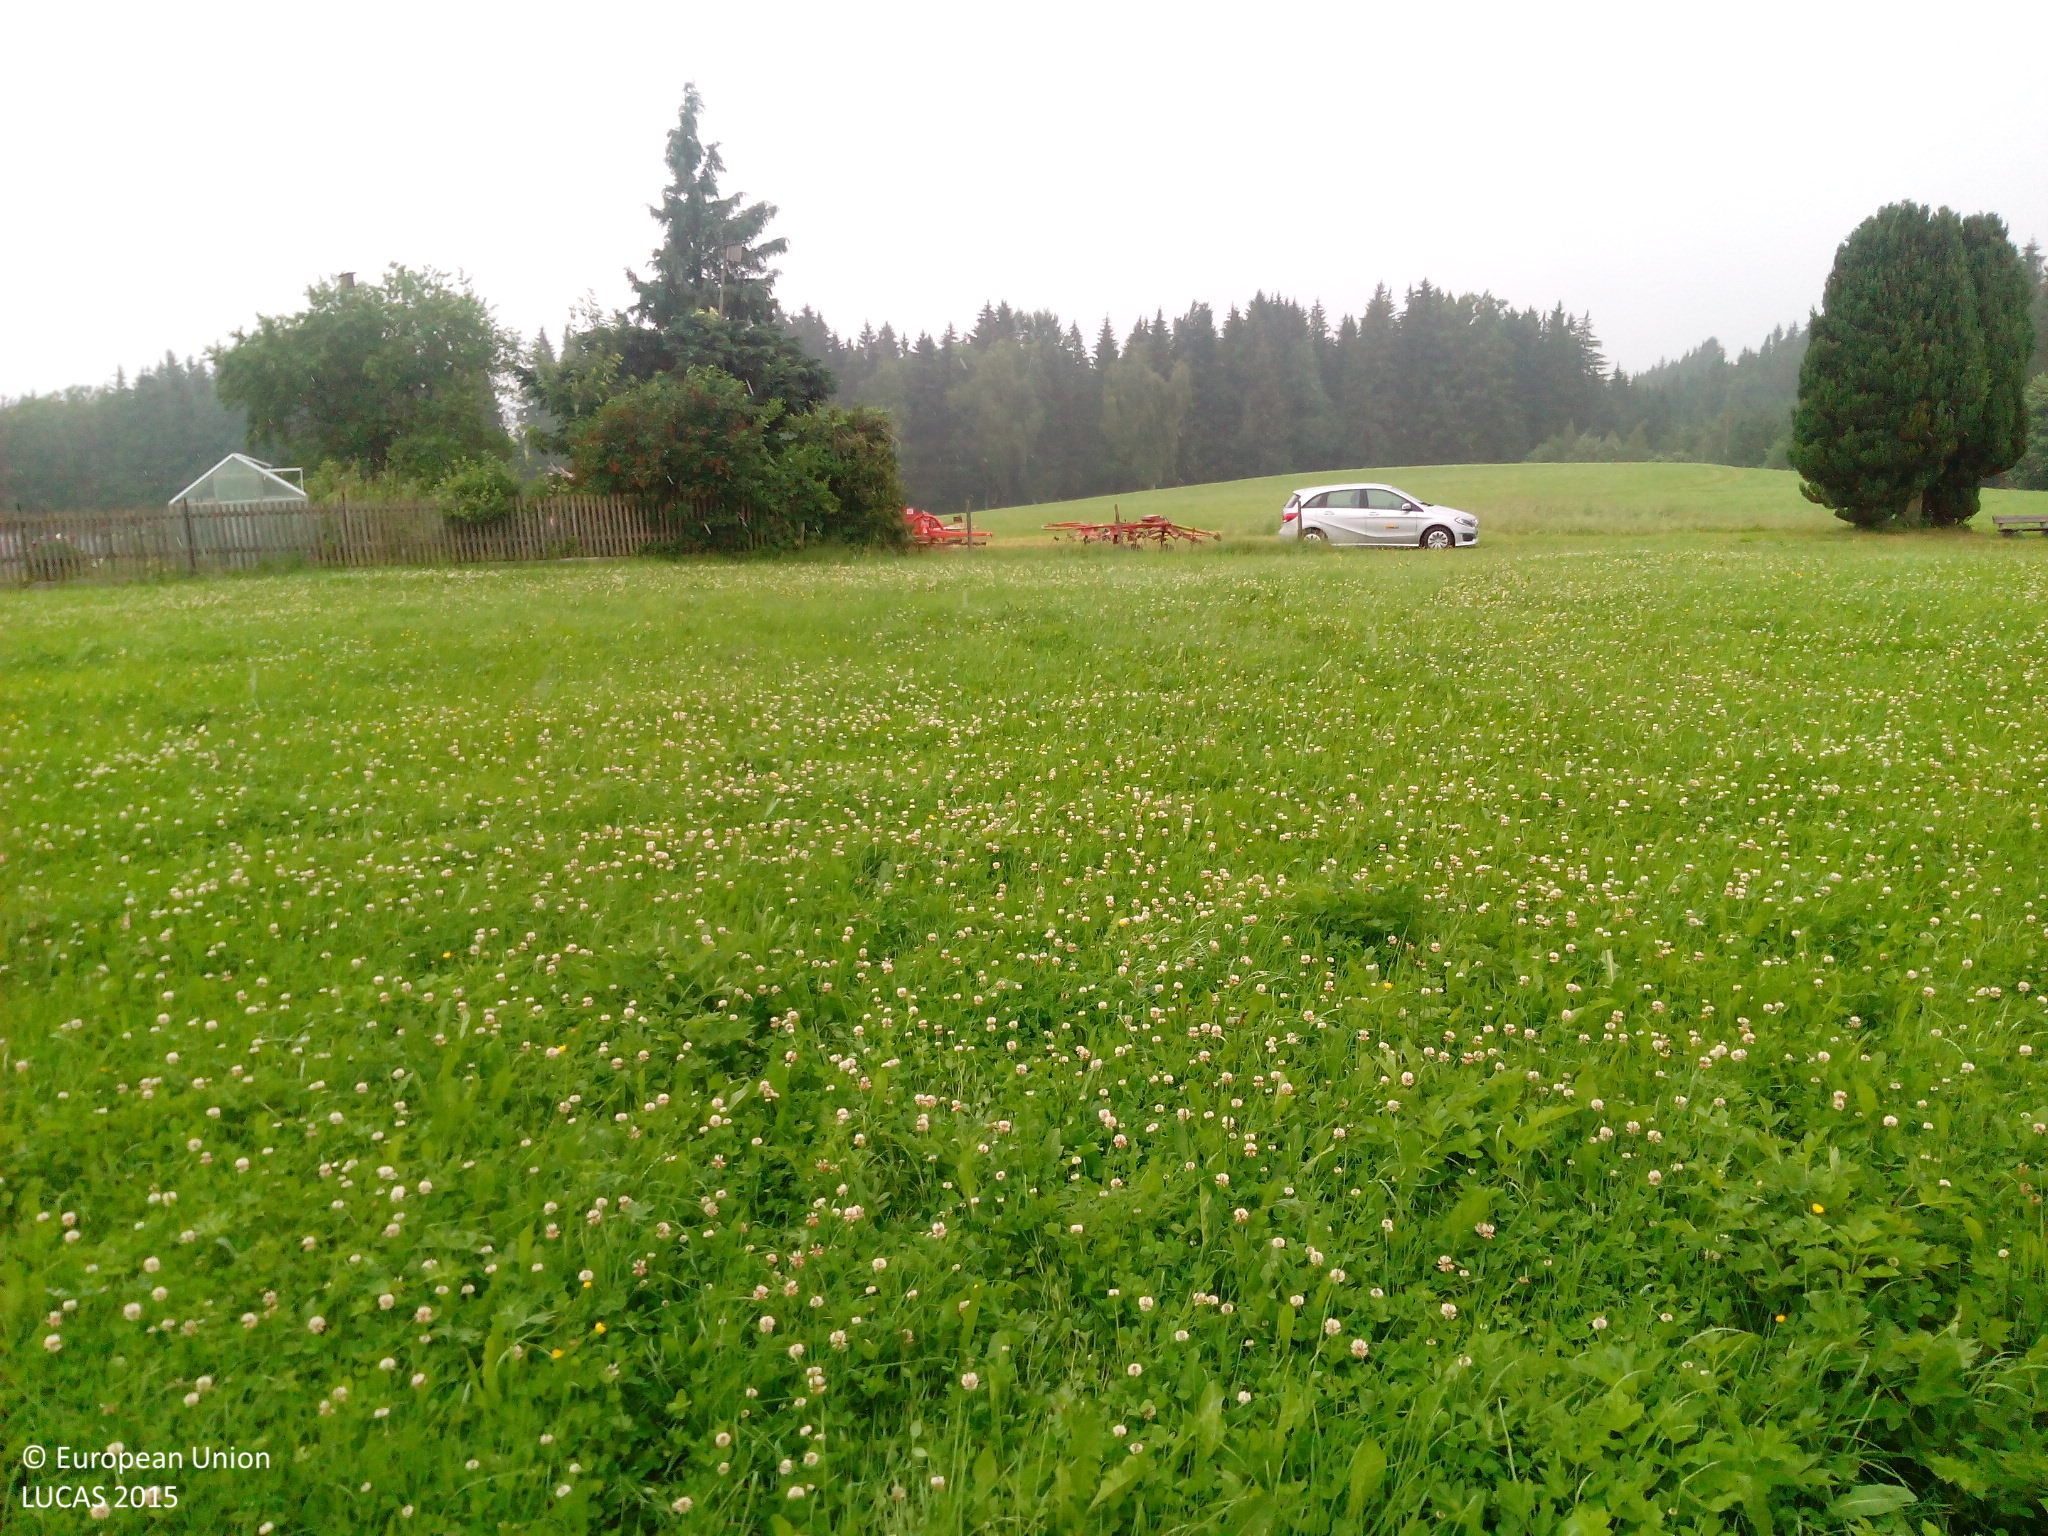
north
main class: Grassland
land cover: Grassland with sparse tree/shrub cover
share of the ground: > 75 %
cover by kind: herbaceous plants 95 %, broadleaved forest trees 5 %
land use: Agriculture (excluding fallow land and kitchen gardens)
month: June
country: DE
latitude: 47.7373
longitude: 10.2532
